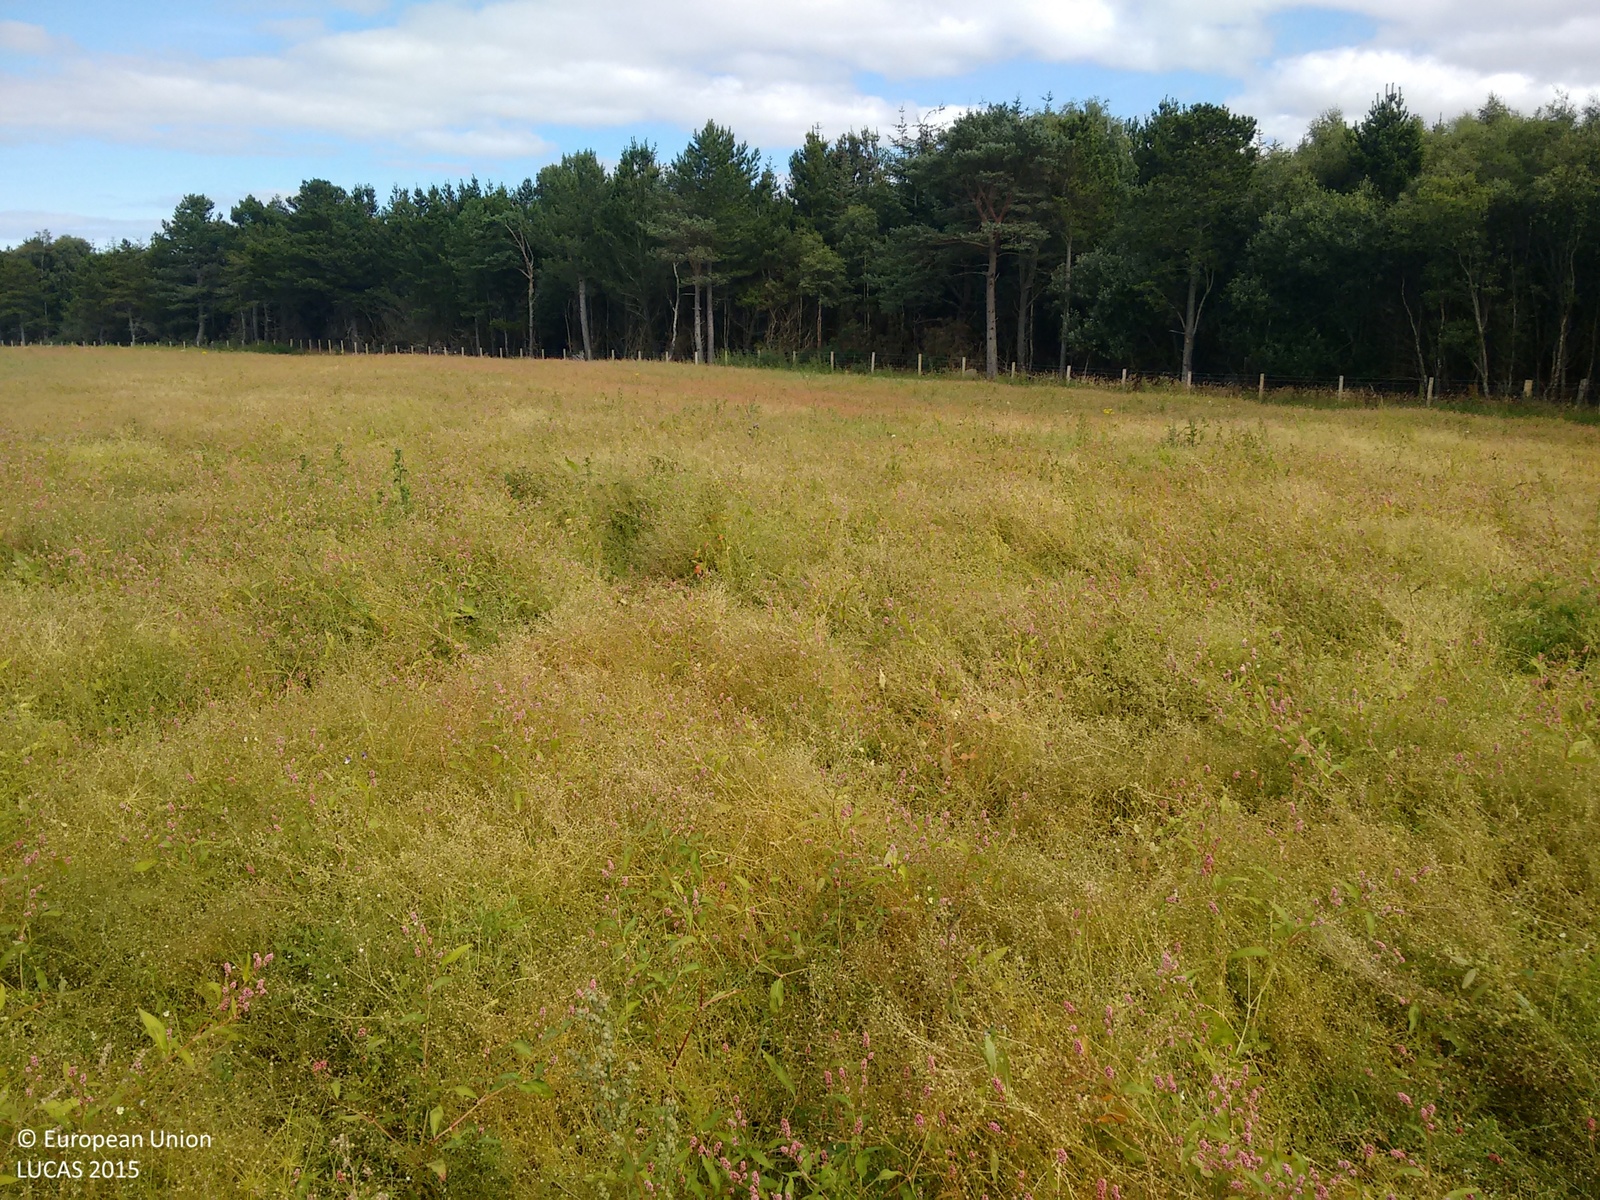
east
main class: Grassland
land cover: Spontaneously vegetated surfaces
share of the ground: > 75 %
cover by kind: herbaceous plants 100 %
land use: Fallow land
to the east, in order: Spontaneously vegetated surfaces; Fences; Spruce dominated mixed woodland; Pine dominated mixed woodland; Broadleaved woodland
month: August
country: GB
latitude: 57.6528
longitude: -3.0482
